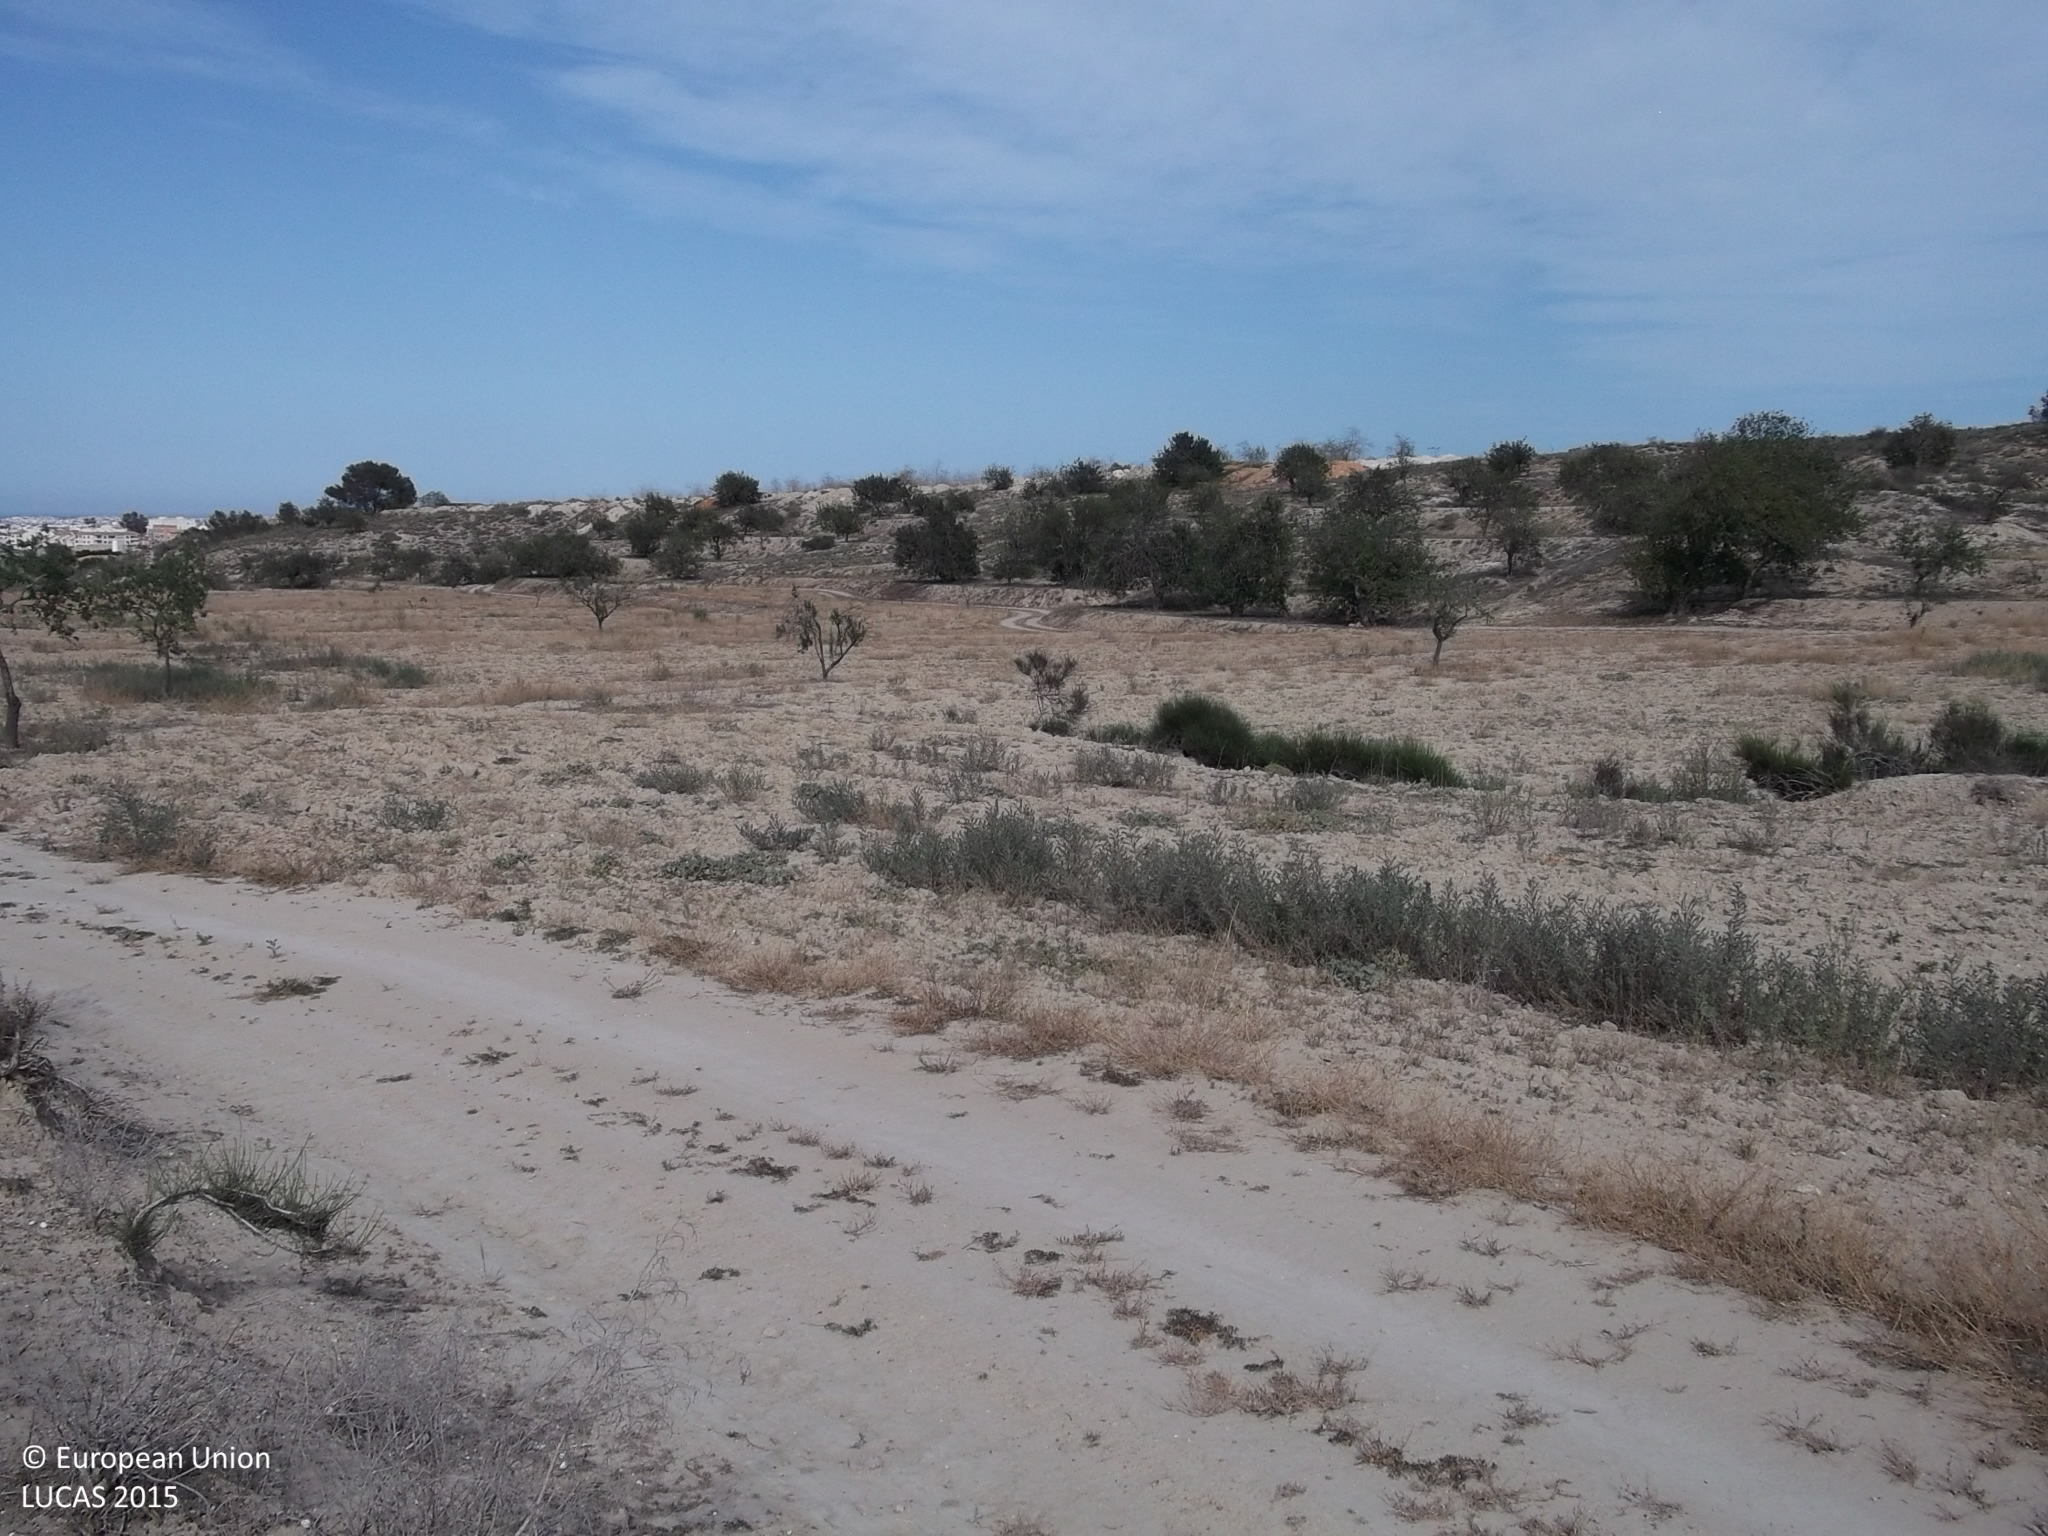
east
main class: Shrubland
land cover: Shrubland without tree cover
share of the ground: 10 - 25 %
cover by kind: consolidated bare surface 50 %, herbaceous plants 30 %, shrubs 20 %
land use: Semi-natural and natural areas not in use
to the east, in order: Shrubland without tree cover; Tracks; Nuts trees; Grass margins; Nuts trees; Grass margins; Nuts trees; Tracks; Other bare soil; Other fruit trees and berries; Grass margins; Nuts trees; Shrubland without tree cover
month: May
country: ES
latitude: 37.9705
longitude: -0.8079
